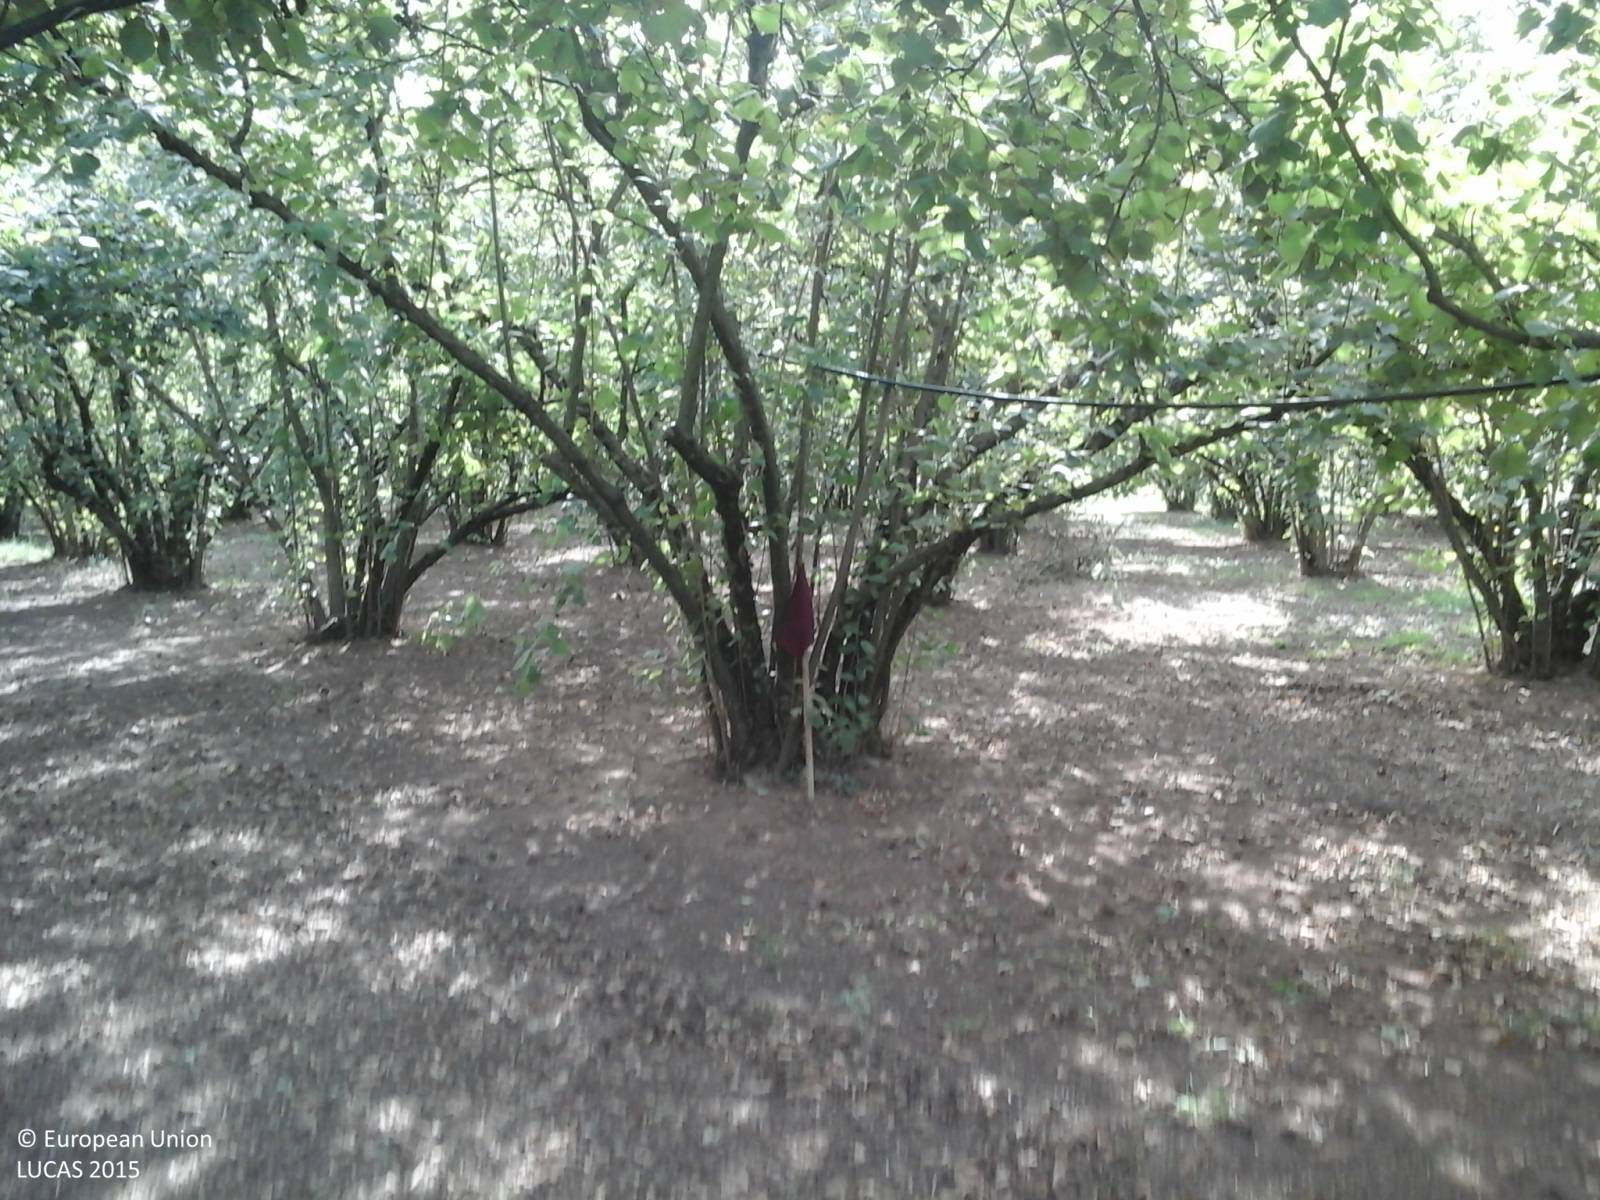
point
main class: Cropland
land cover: Nuts trees
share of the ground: > 75 %
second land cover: Other bare soil
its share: > 75 %
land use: Agriculture (excluding fallow land and kitchen gardens)
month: September
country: IT
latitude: 42.3741
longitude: 12.3359
